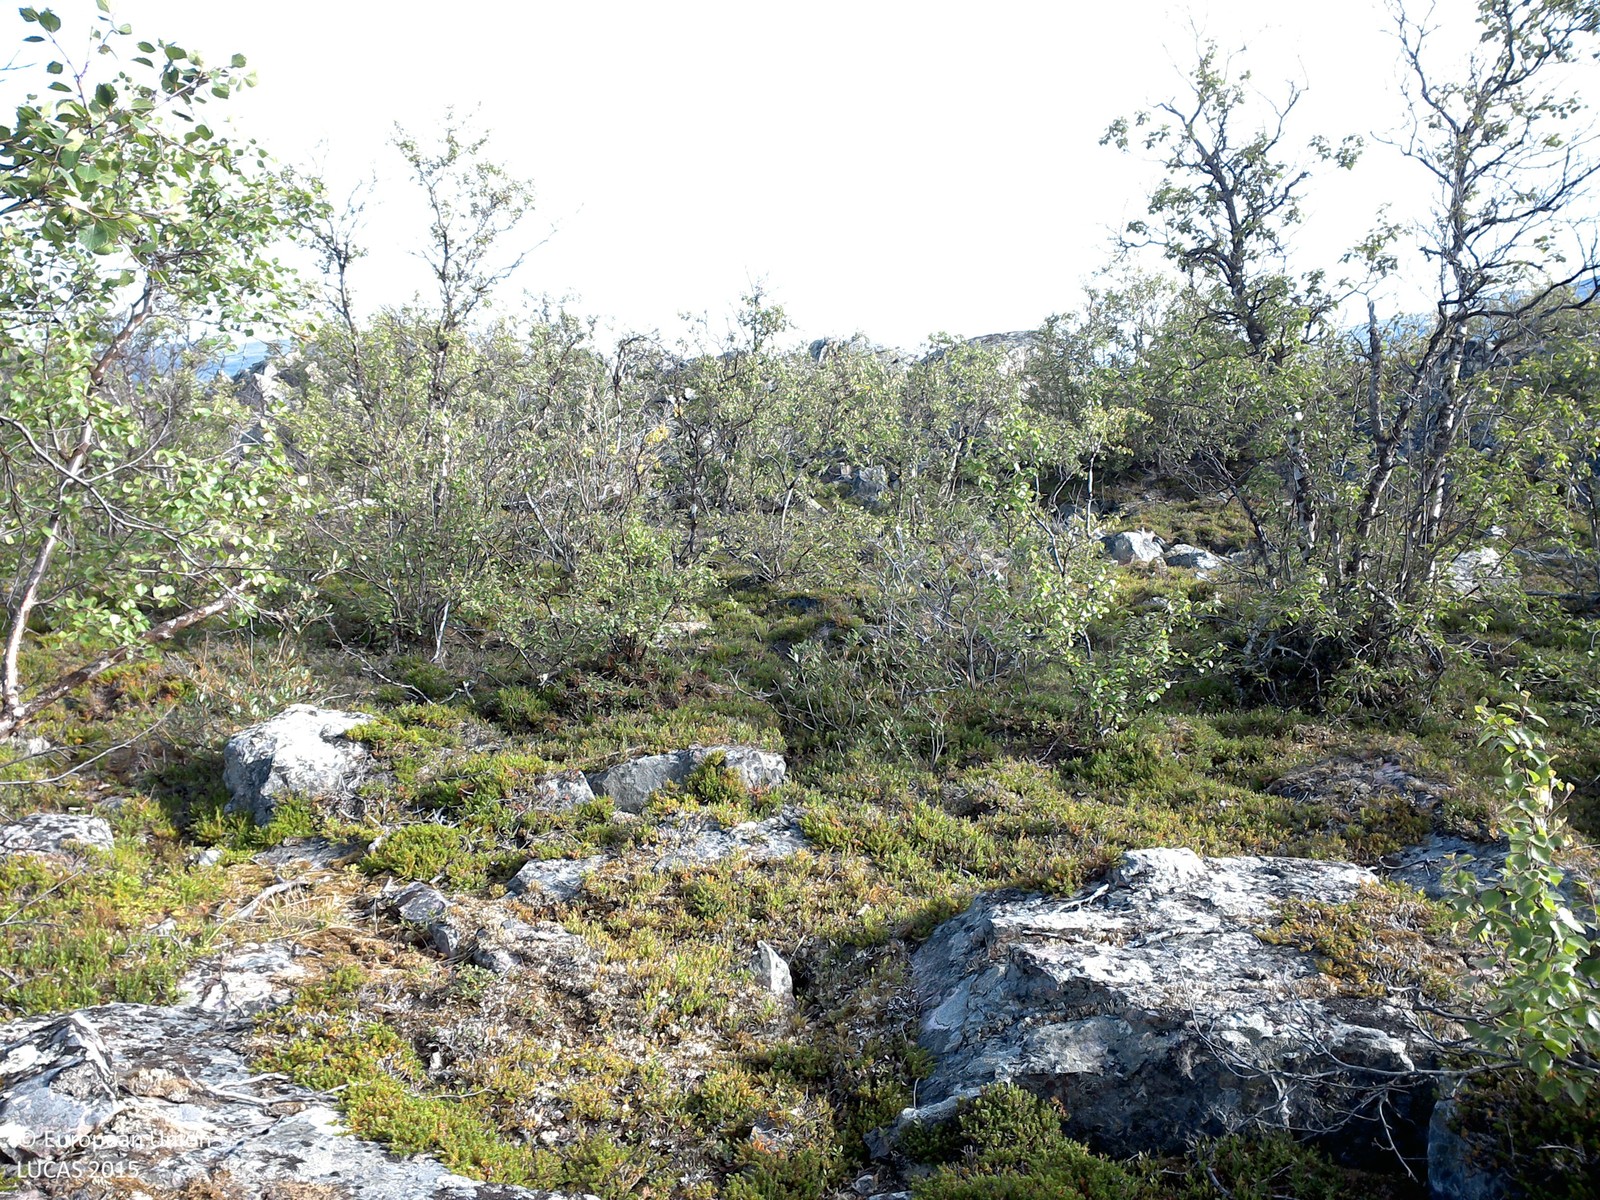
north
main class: Woodland
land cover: Broadleaved woodland
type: boreal forest
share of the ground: 10 - 25 %
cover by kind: shrubs 55 %, broadleaved forest trees 20 %, lichens and mosses 20 %, unconsolidated bare surface 5 %
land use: Amenities, museums, leisure
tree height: < 5 m
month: August
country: SE
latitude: 68.3500
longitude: 19.0885
